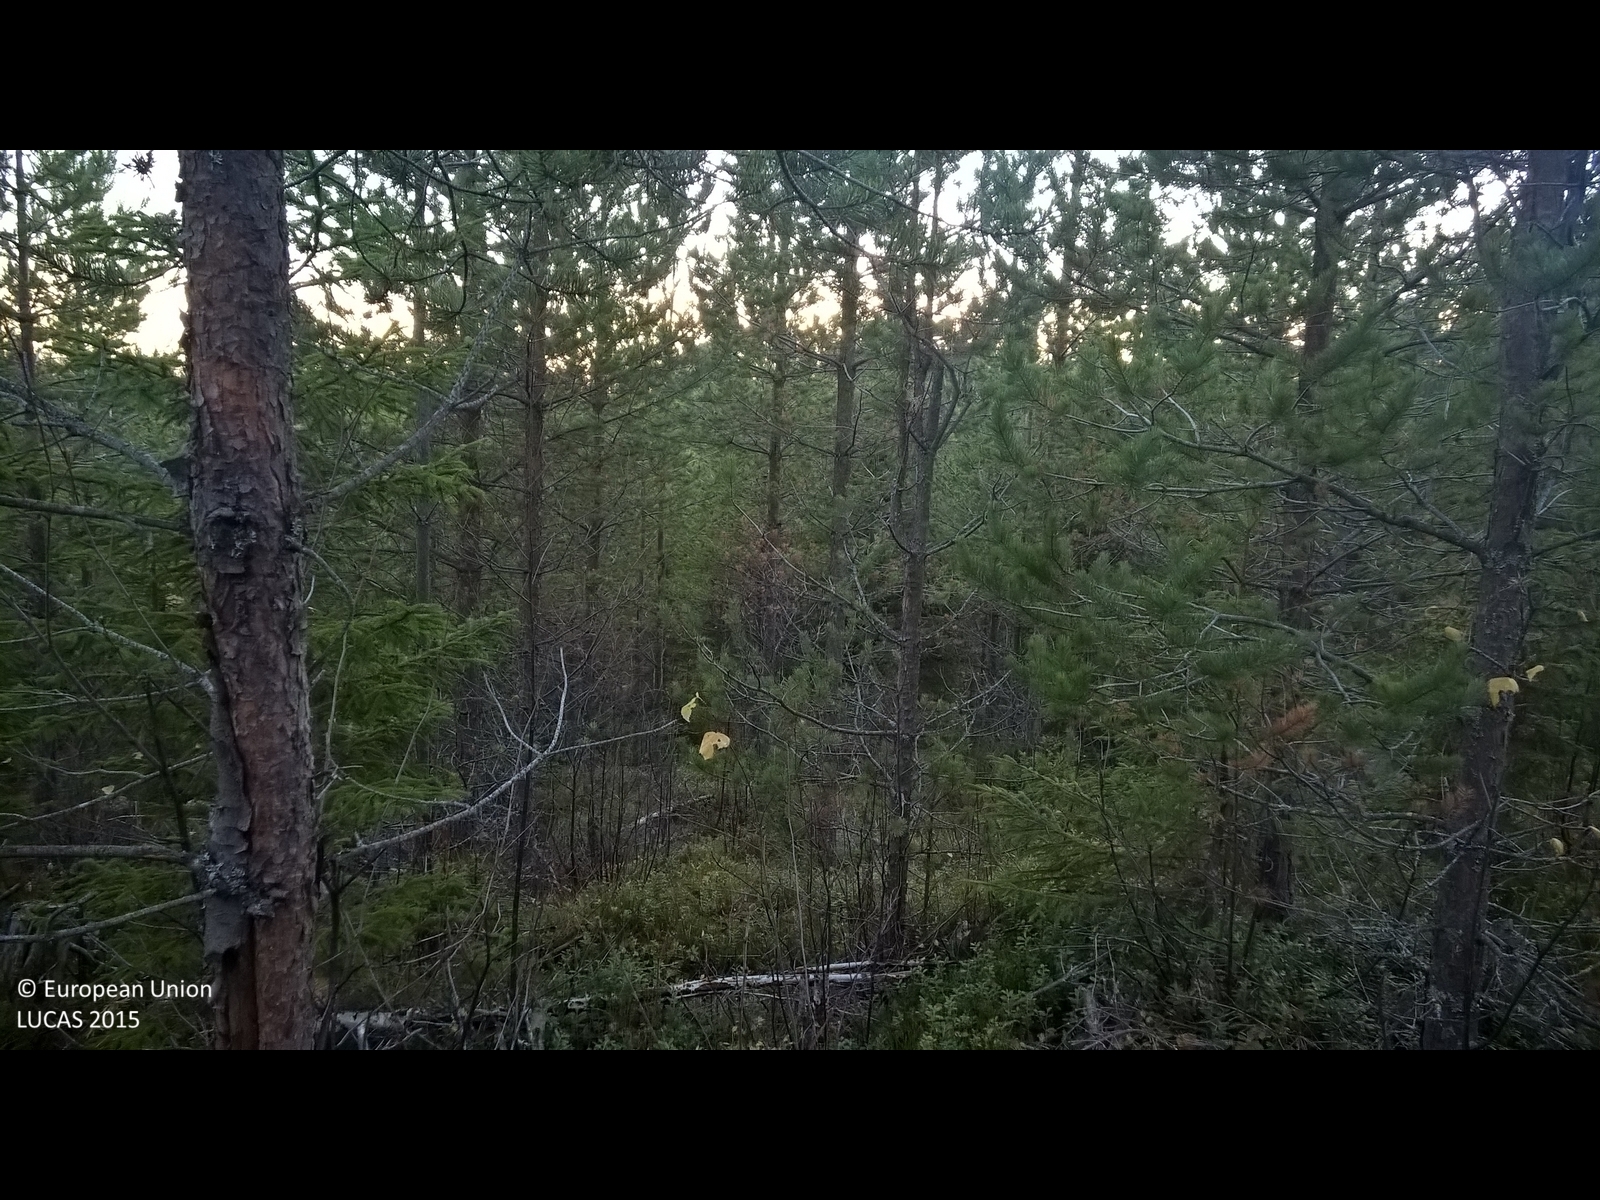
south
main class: Woodland
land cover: Spruce dominated coniferous woodland
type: boreal forest
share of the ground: 50 - 75 %
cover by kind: coniferous forest trees 70 %, lichens and mosses 30 %
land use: Forestry
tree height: > 5 m
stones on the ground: < 10 %
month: October
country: SE
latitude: 62.9575
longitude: 15.6751
